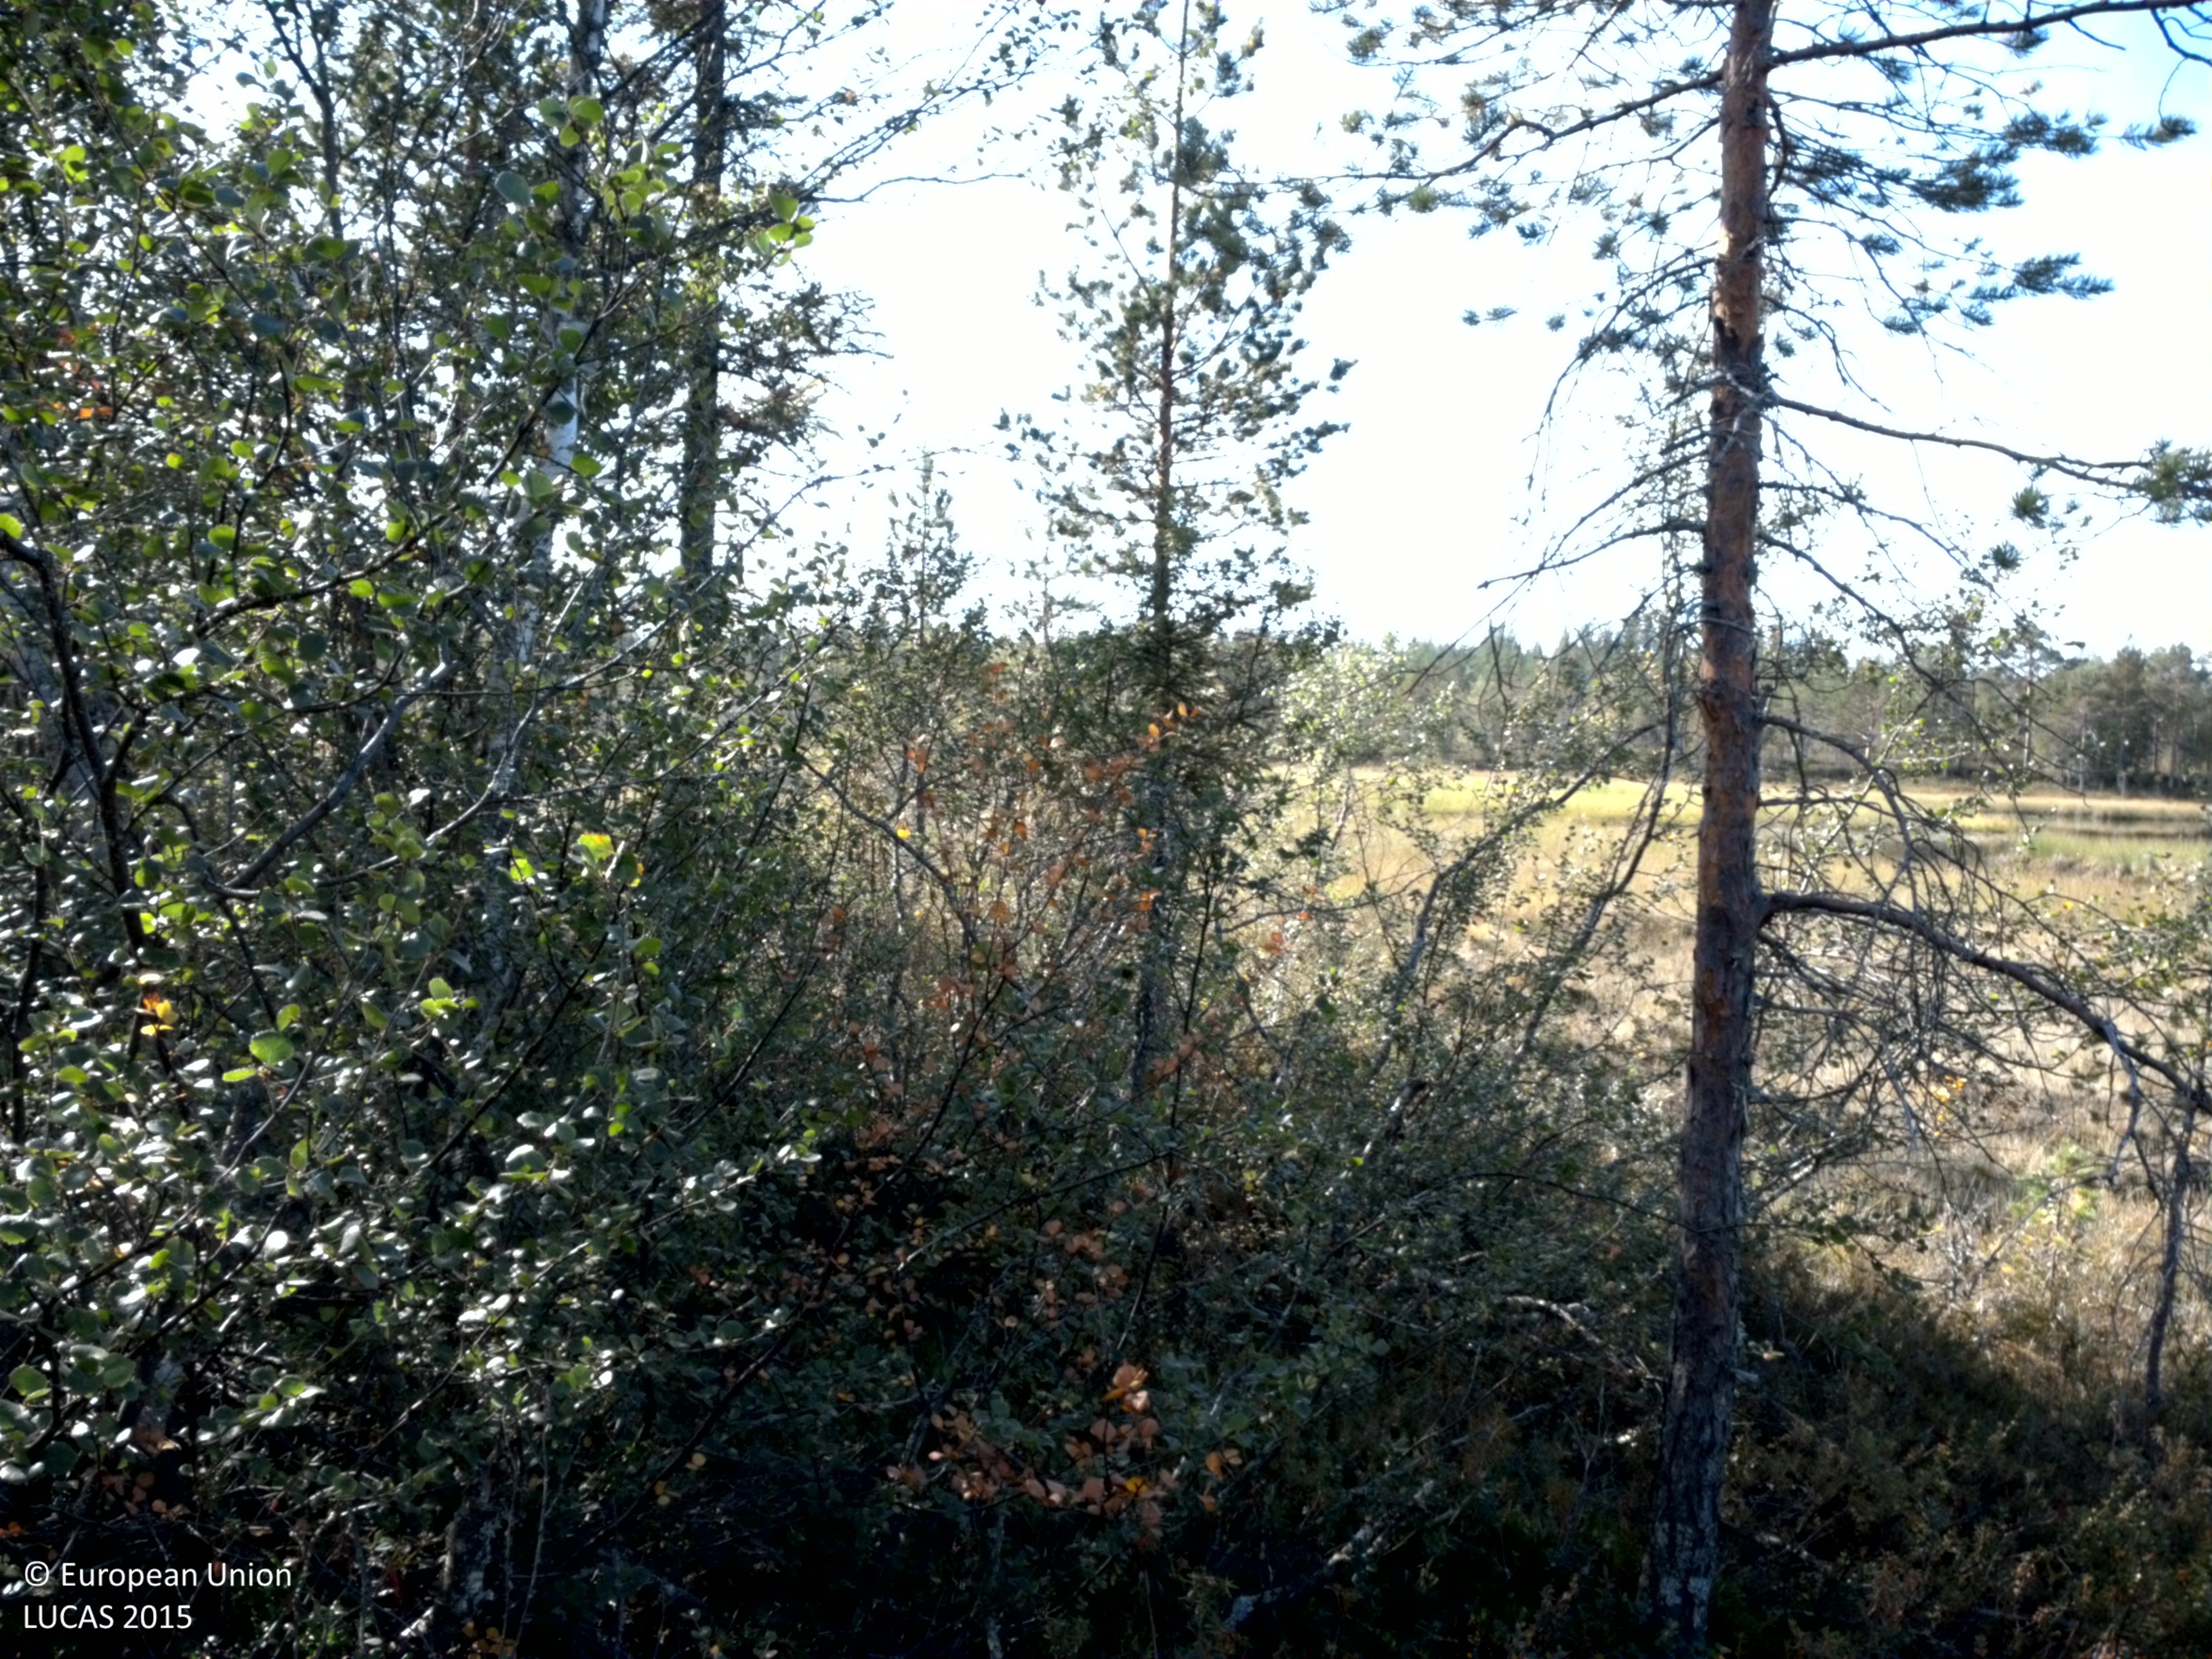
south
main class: Woodland
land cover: Pine dominated mixed woodland
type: boreal forest
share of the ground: 50 - 75 %
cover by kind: coniferous forest trees 45 %, shrubs 35 %, broadleaved forest trees 15 %, lichens and mosses 5 %
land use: Semi-natural and natural areas not in use
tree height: > 5 m
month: August
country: SE
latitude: 64.6124
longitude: 18.7269
